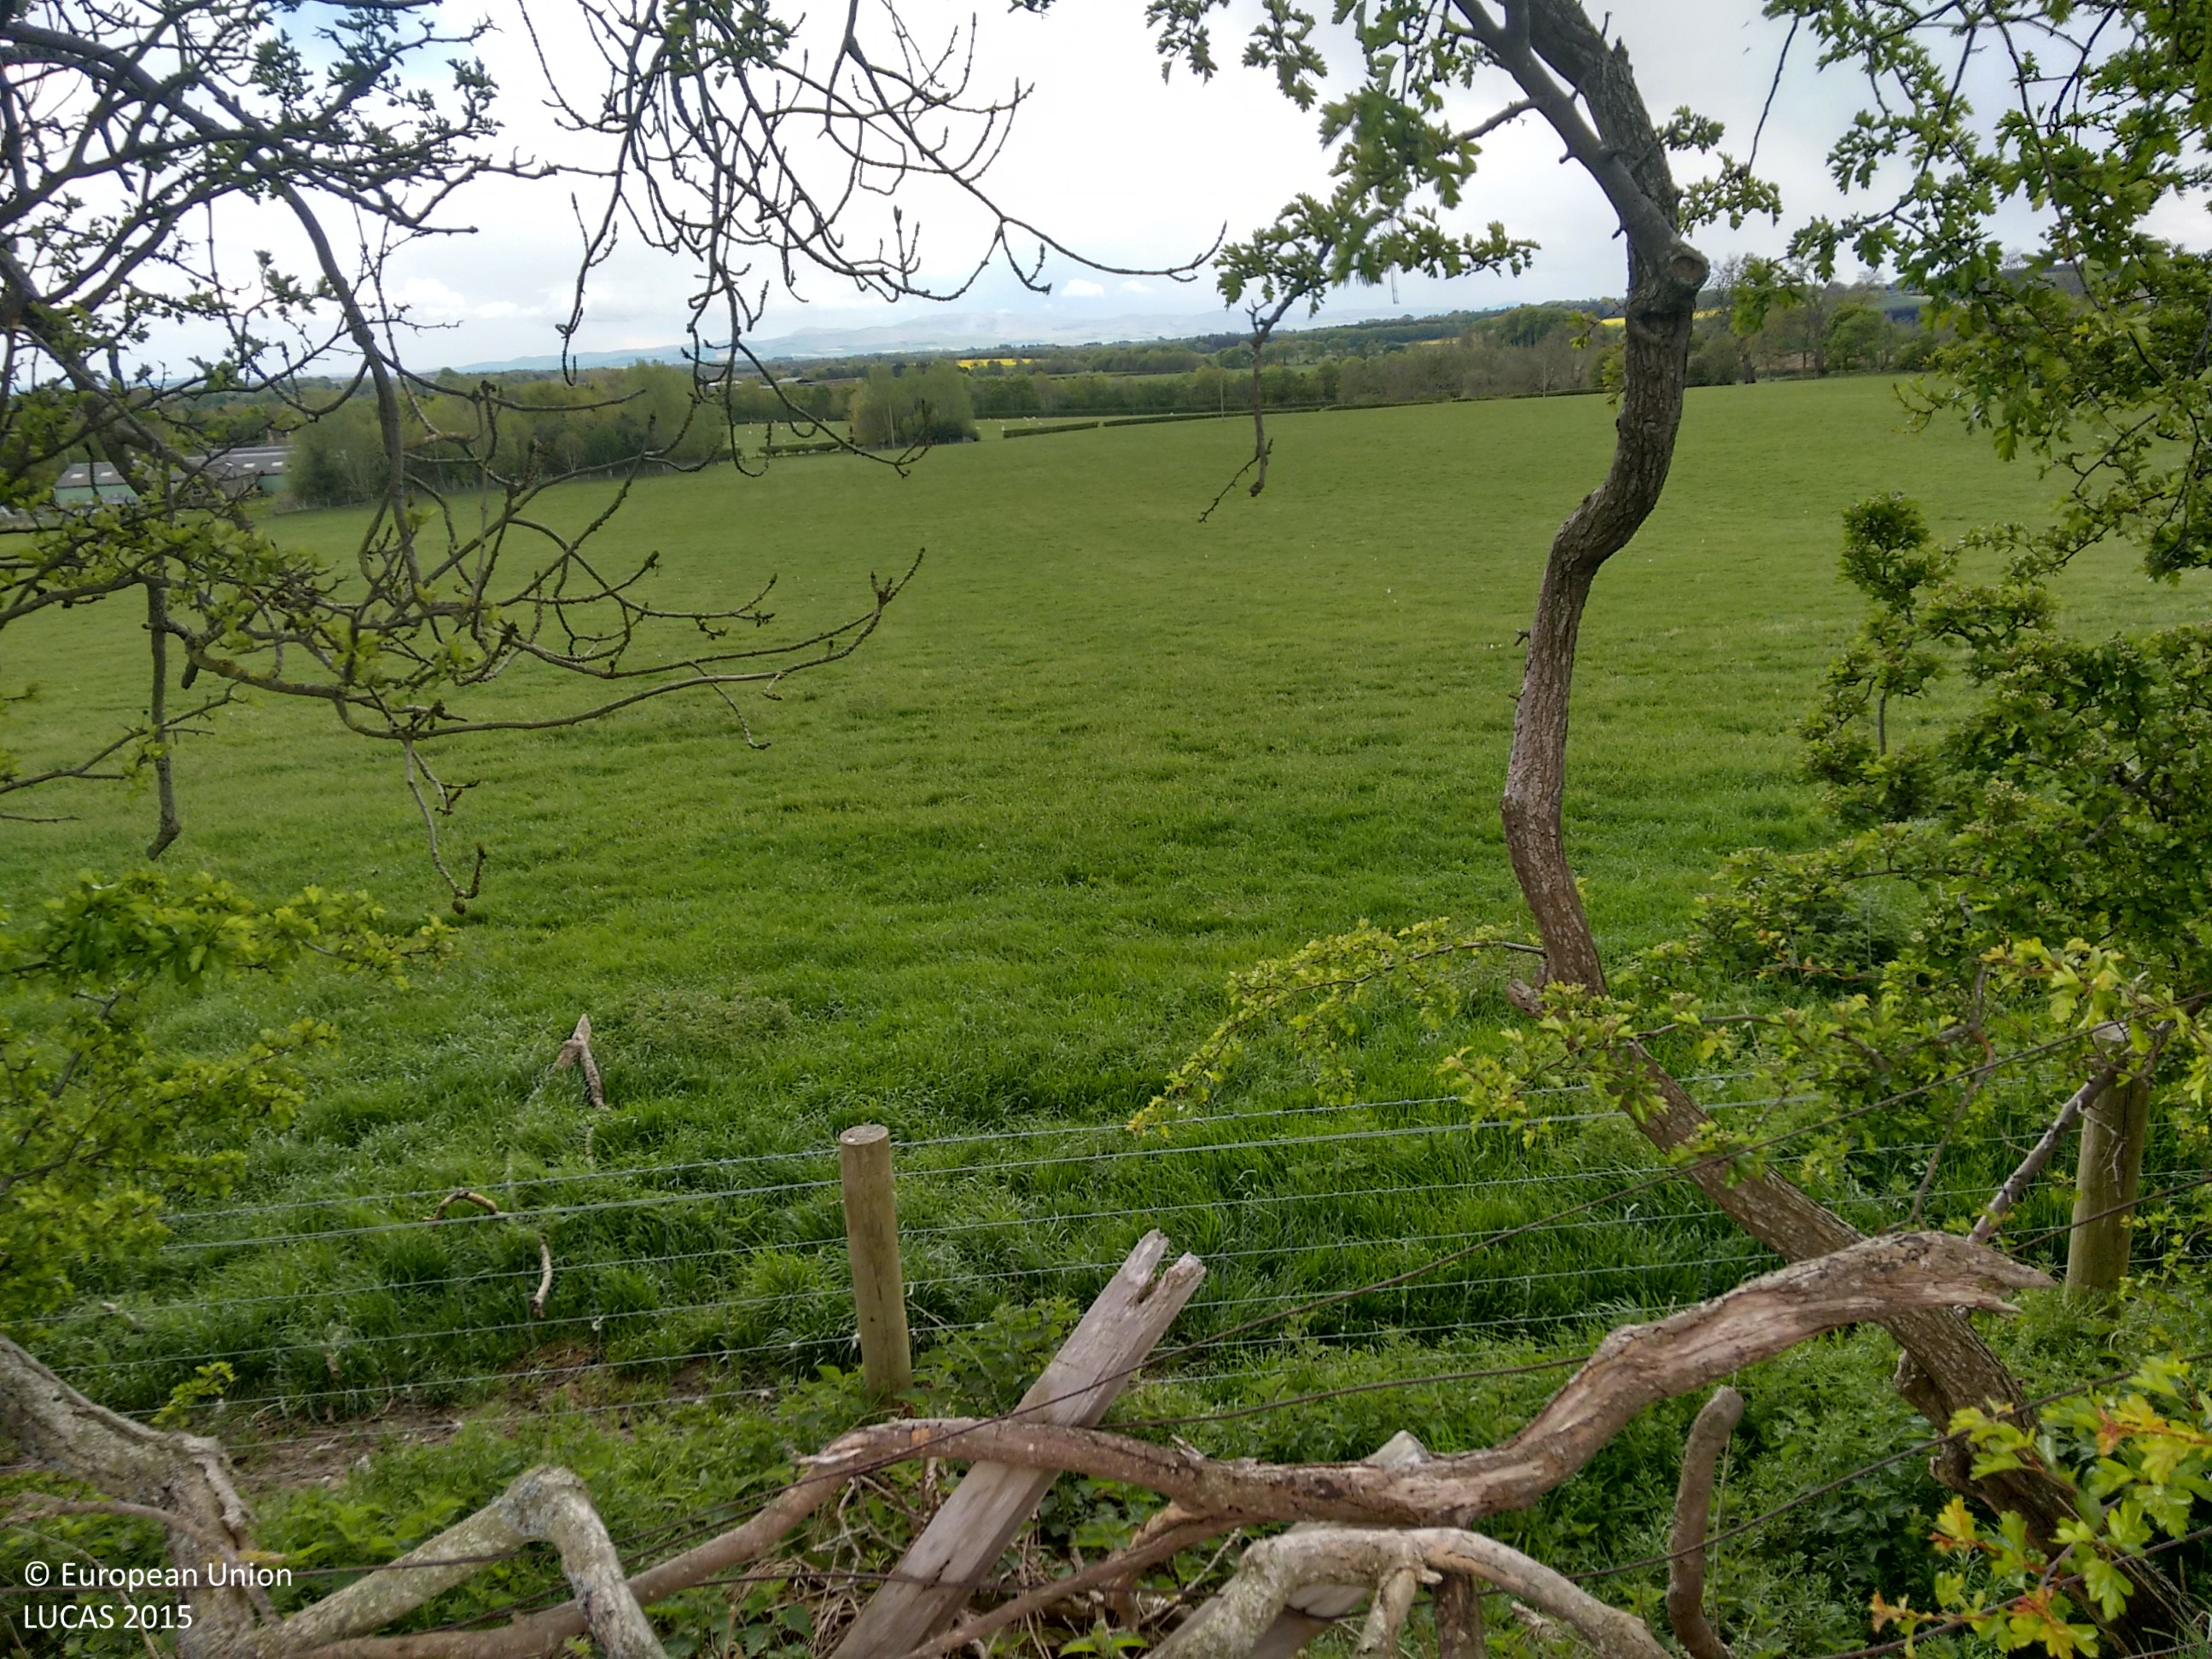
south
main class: Grassland
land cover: Grassland without tree/shrub cover
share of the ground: > 75 %
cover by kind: herbaceous plants 100 %
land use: Agriculture (excluding fallow land and kitchen gardens)
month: May
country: GB
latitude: 55.8122
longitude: -2.2959
